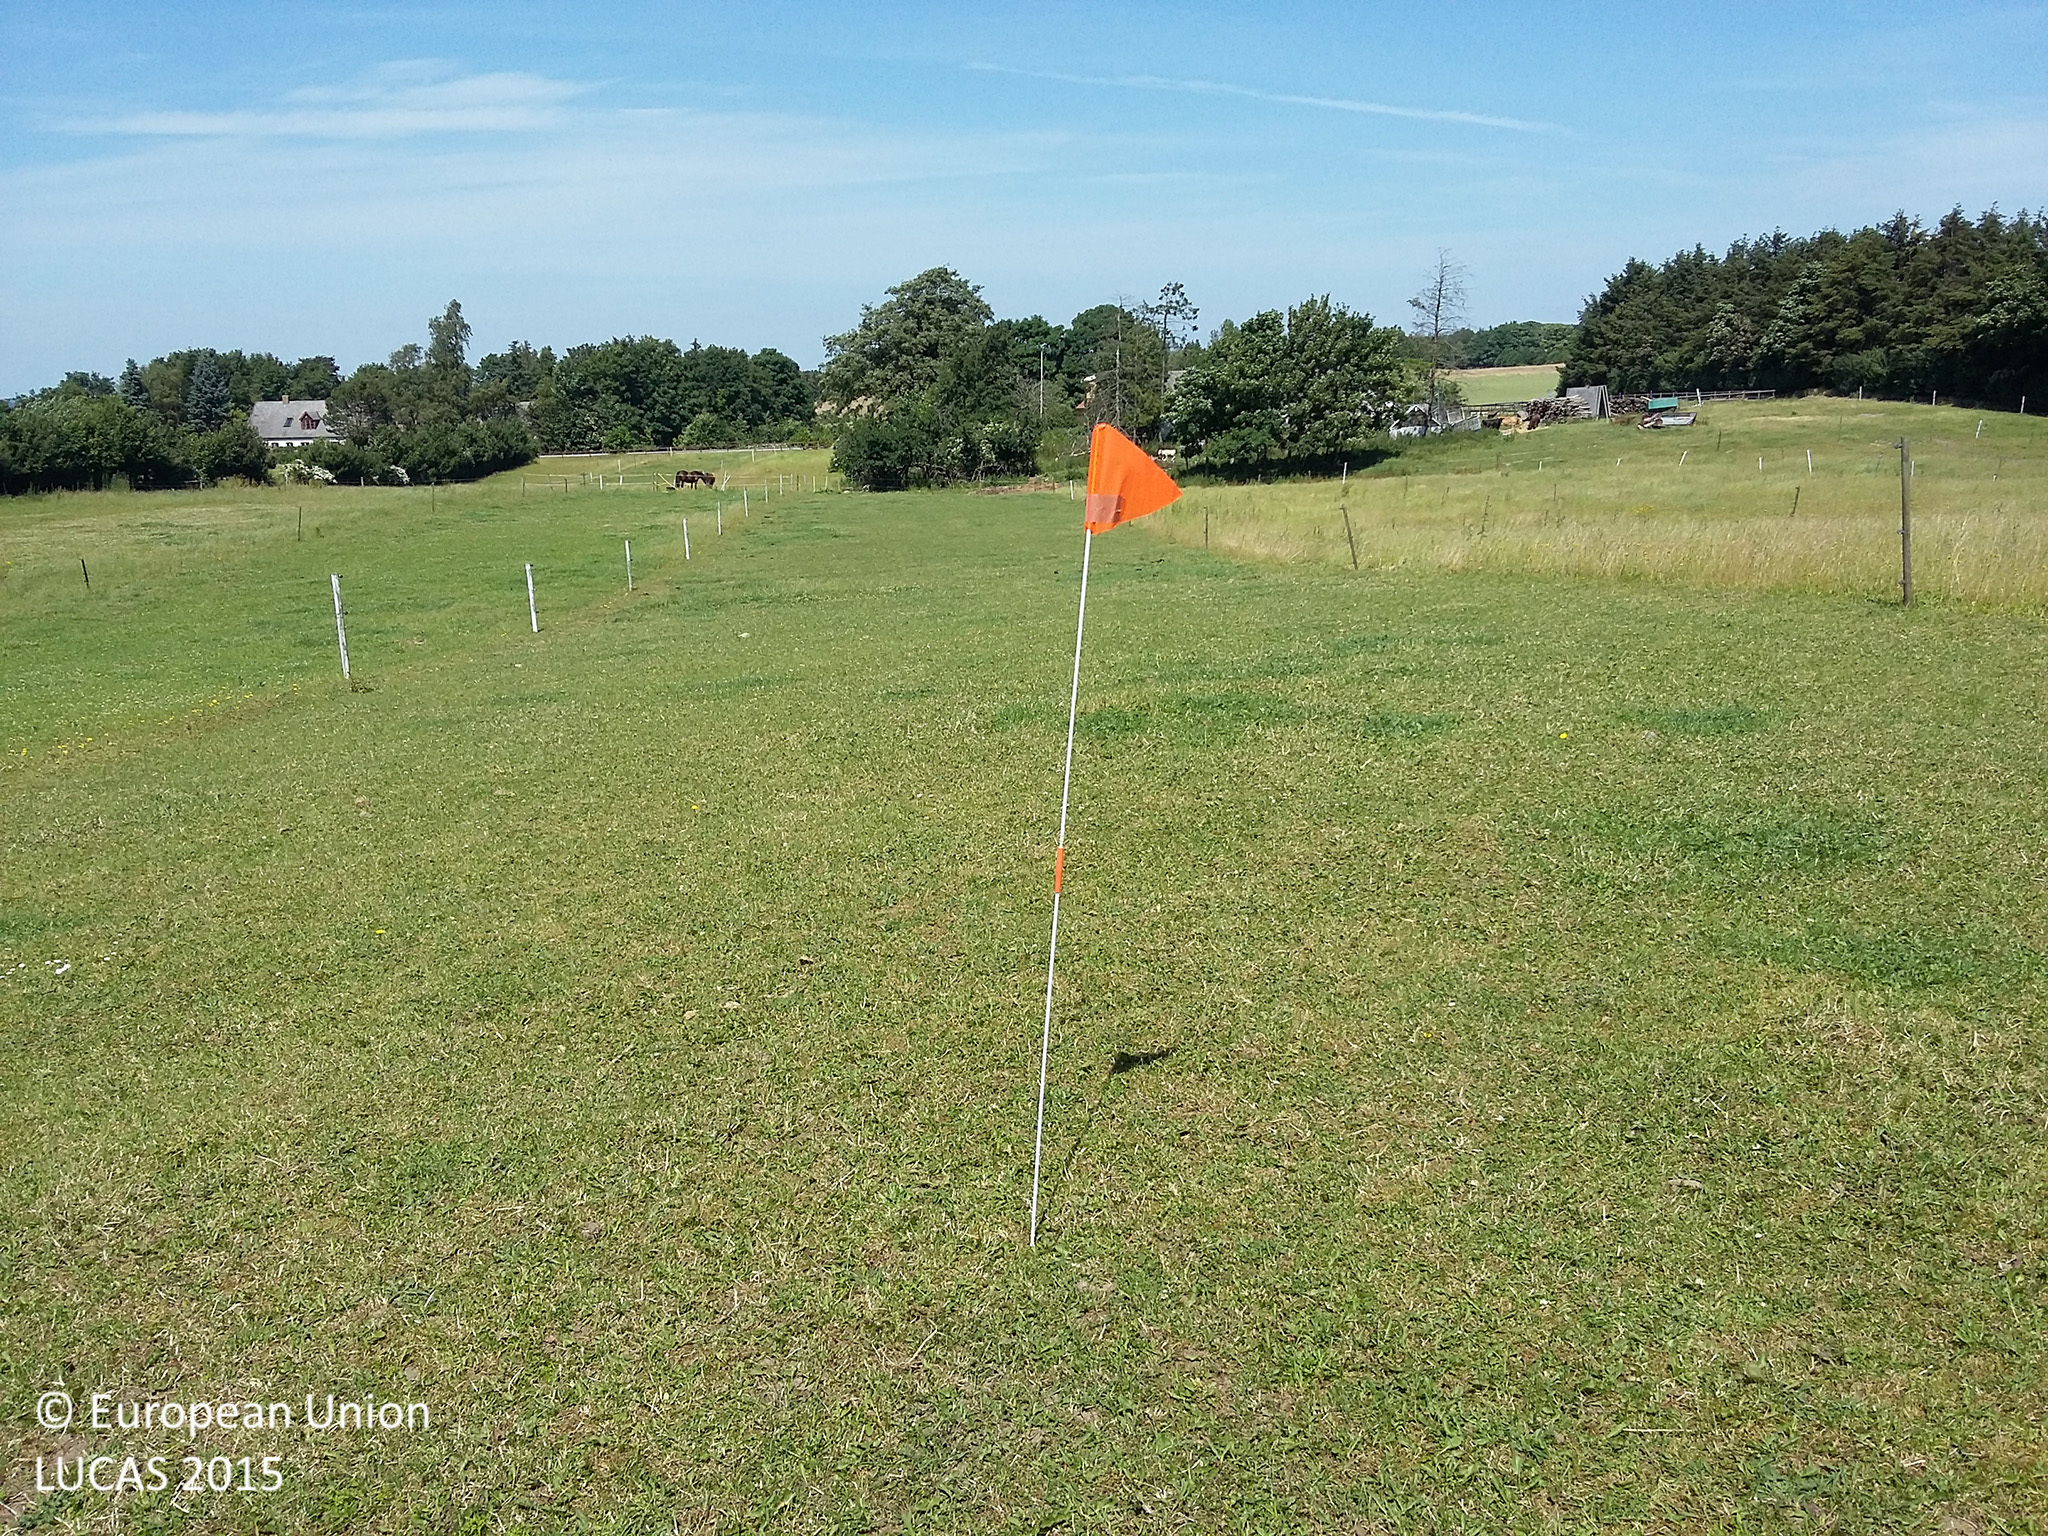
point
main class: Grassland
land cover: Grassland without tree/shrub cover
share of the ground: > 75 %
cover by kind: herbaceous plants 100 %
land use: Agriculture (excluding fallow land and kitchen gardens)
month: July
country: DK
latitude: 55.2567
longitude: 11.9023
